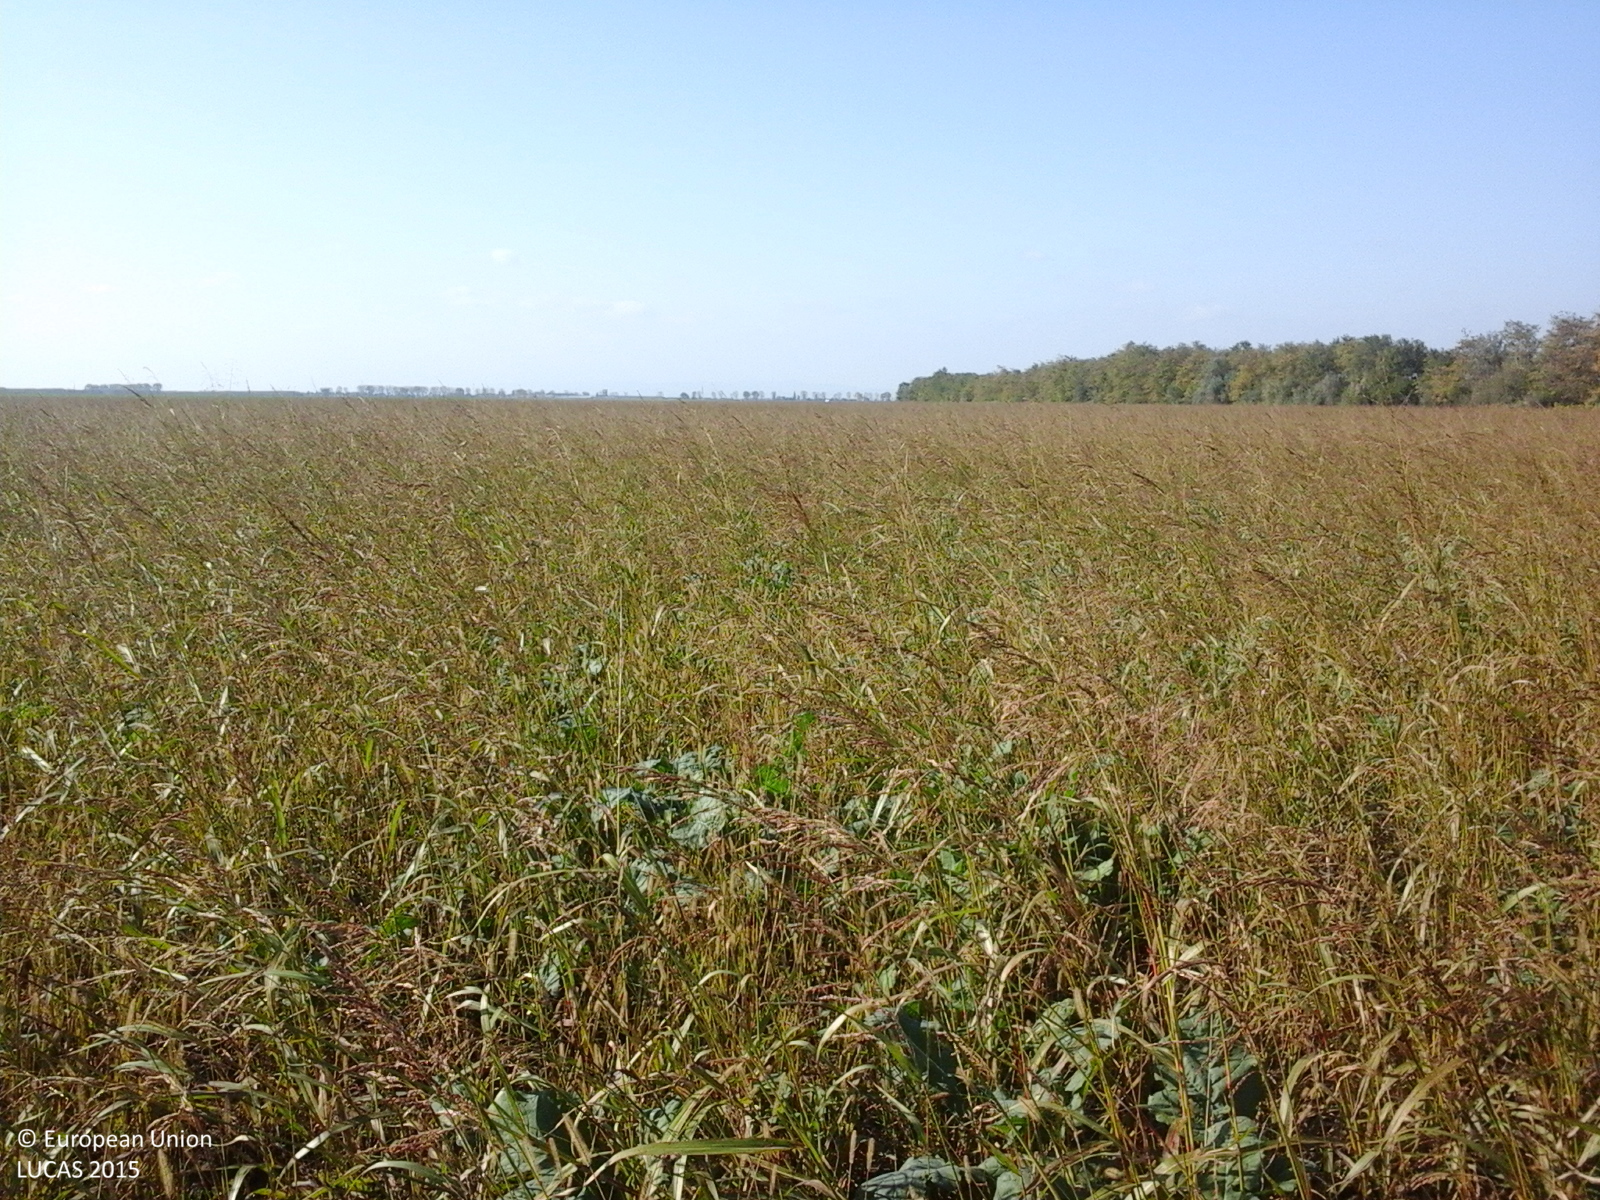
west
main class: Grassland
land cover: Spontaneously vegetated surfaces
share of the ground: > 75 %
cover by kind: herbaceous plants 100 %
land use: Fallow land
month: October
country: RO
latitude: 45.4494
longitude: 27.3723
